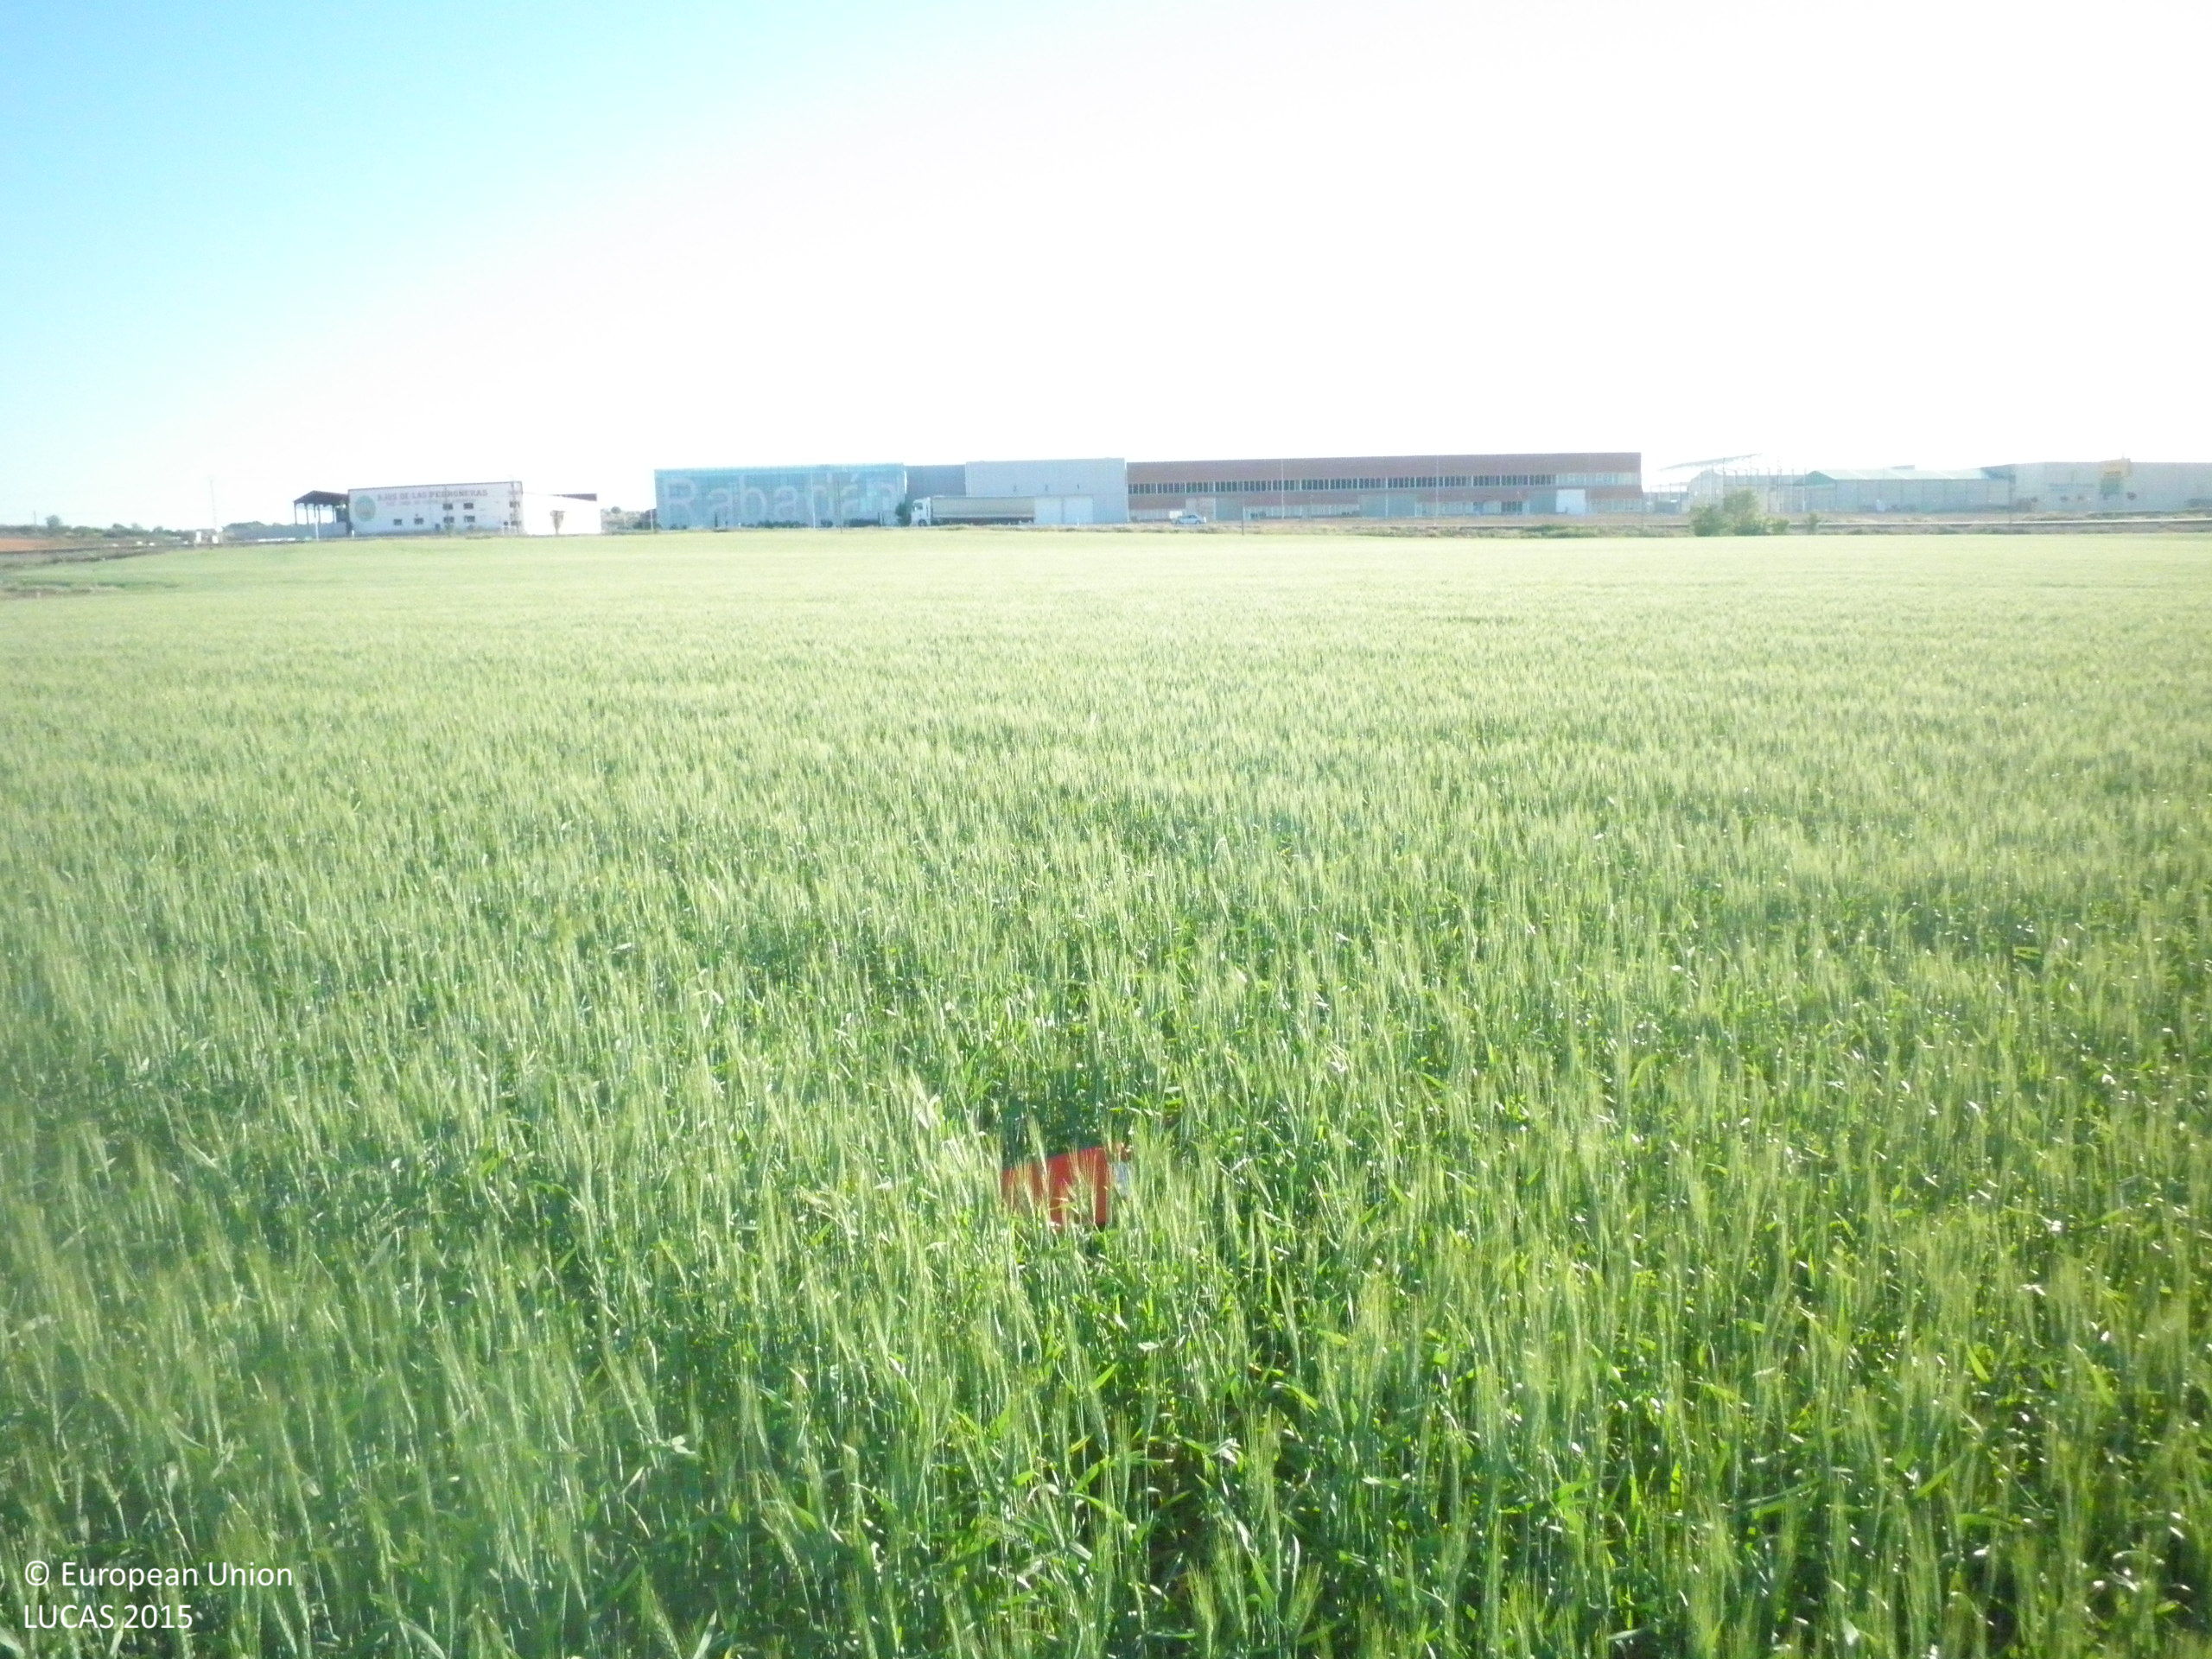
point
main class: Cropland
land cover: Durum wheat
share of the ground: > 75 %
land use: Agriculture (excluding fallow land and kitchen gardens)
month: May
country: ES
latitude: 39.4576
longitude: -2.6929
